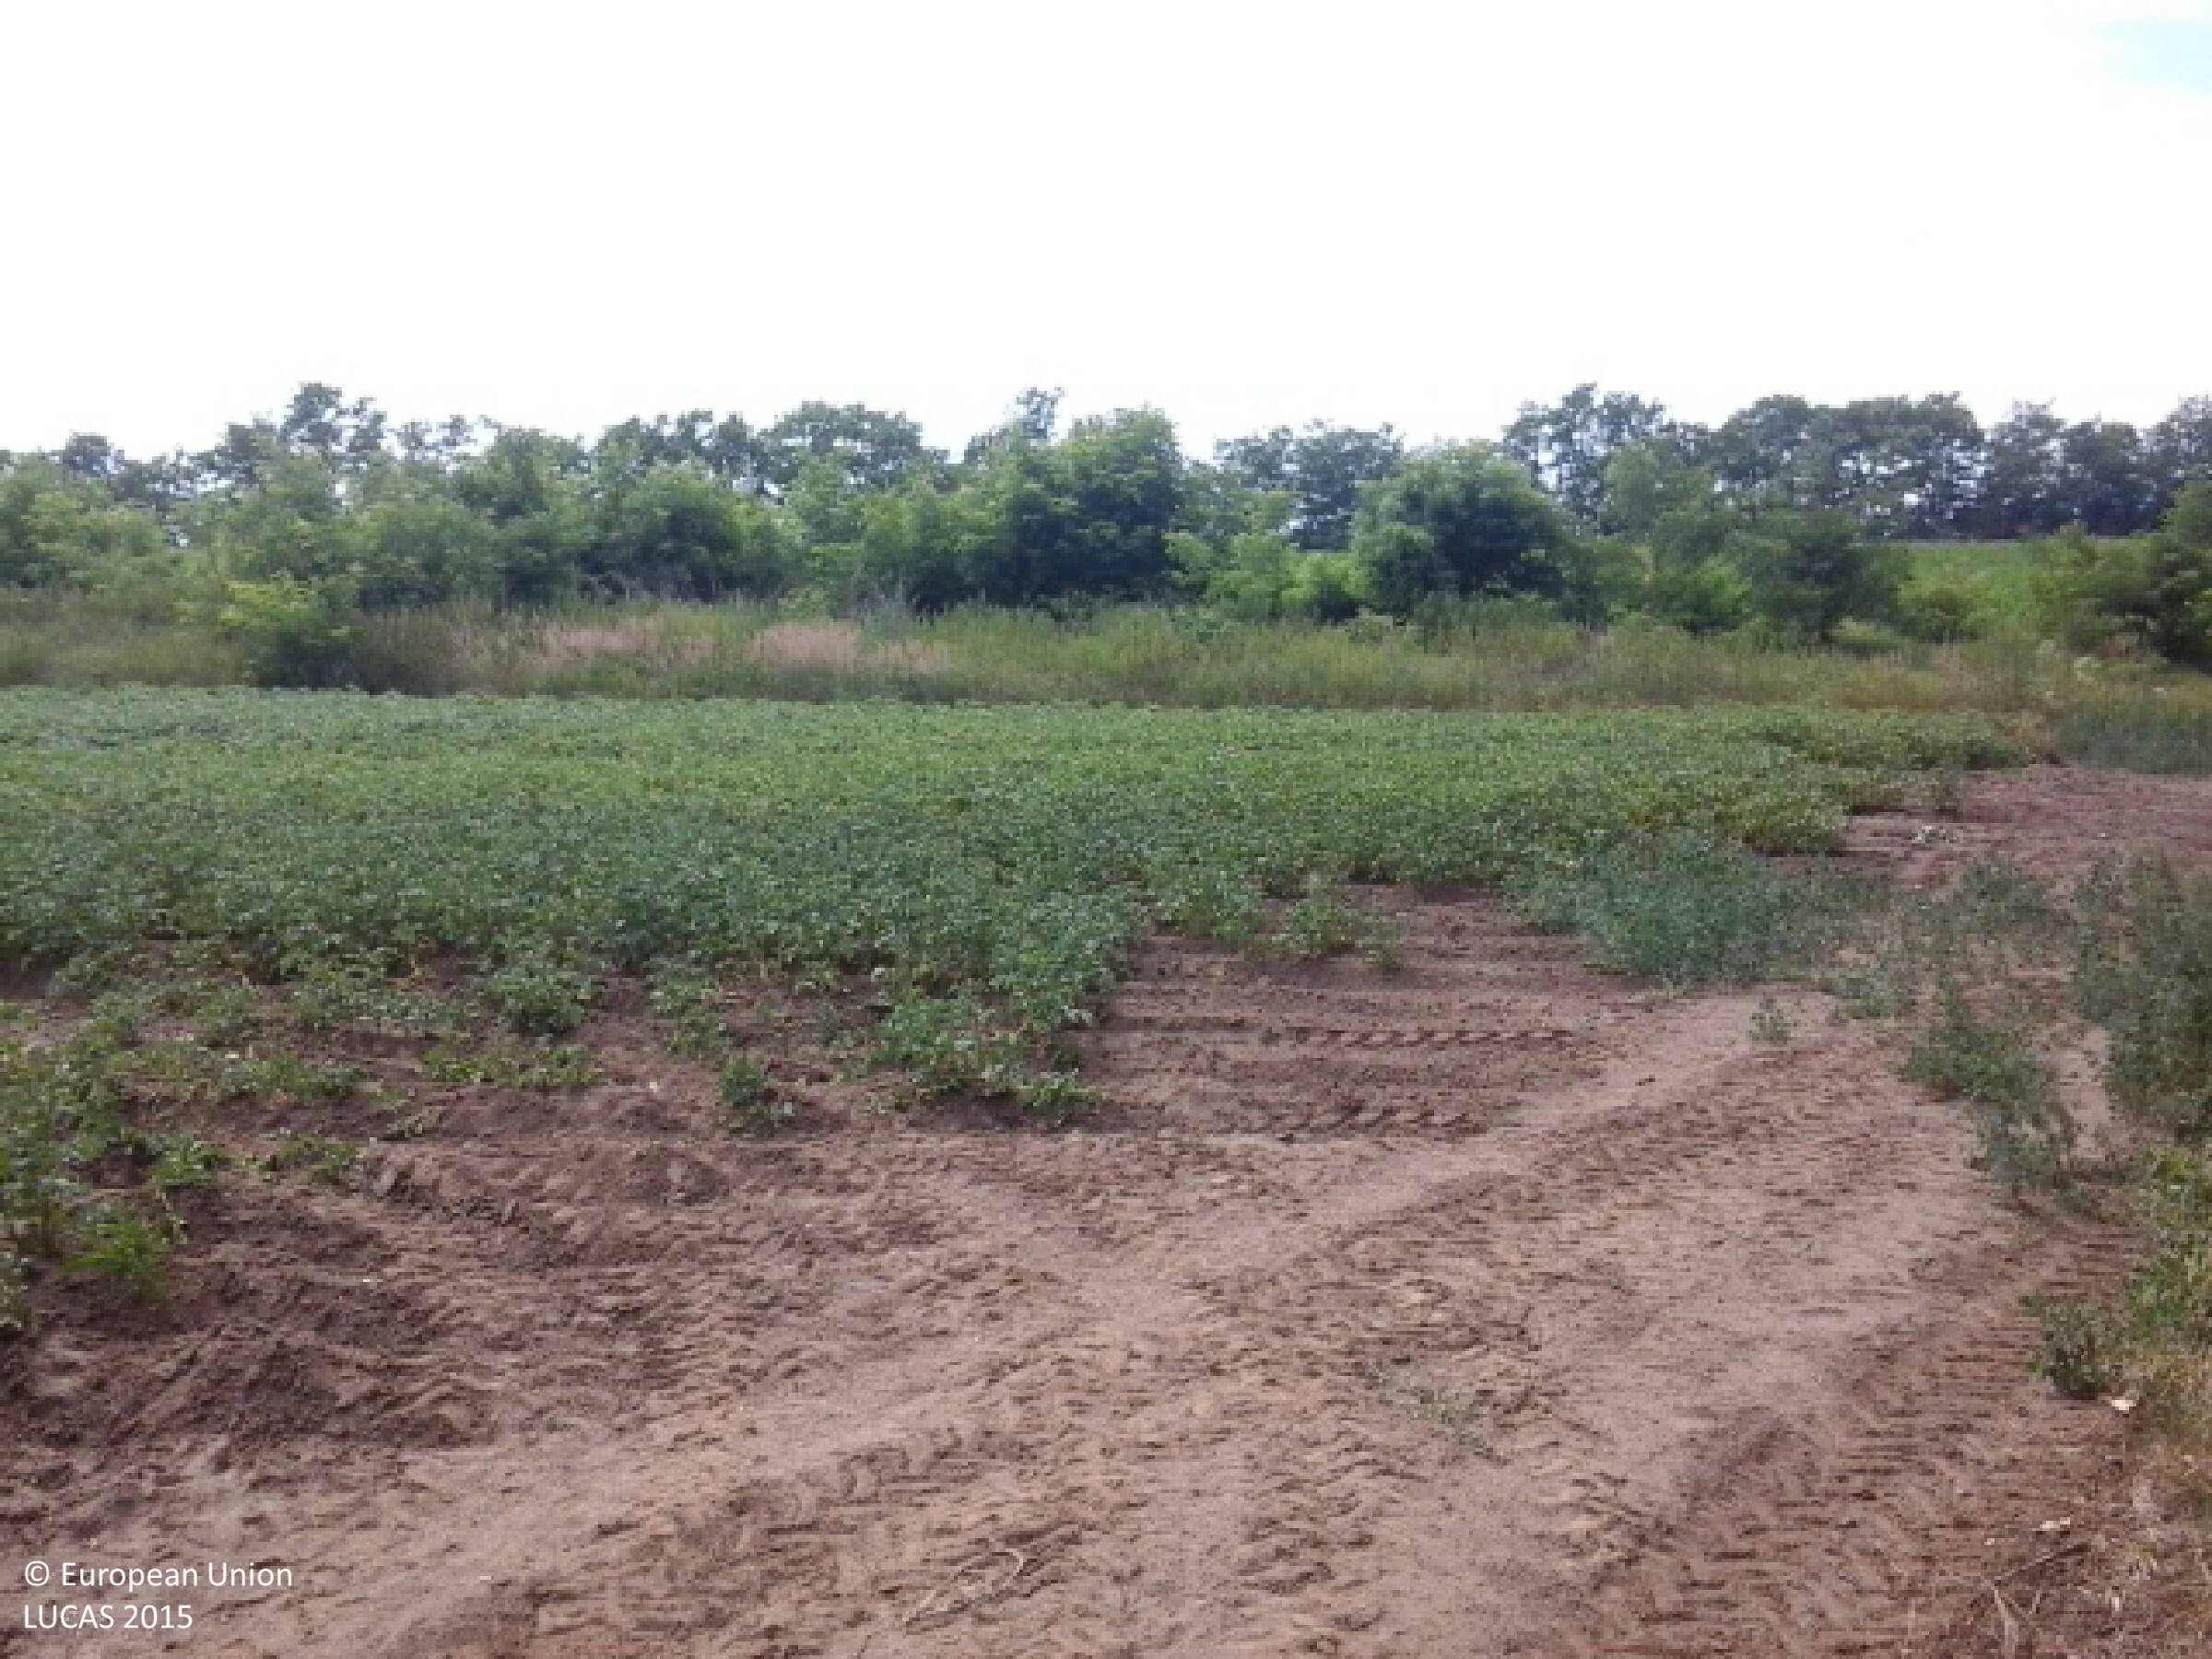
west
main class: Shrubland
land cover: Shrubland with sparse tree cover
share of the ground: 50 - 75 %
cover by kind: shrubs 70 %, herbaceous plants 25 %, broadleaved forest trees 5 %
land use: Road transport
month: June
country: HU
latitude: 48.0717
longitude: 21.5208
